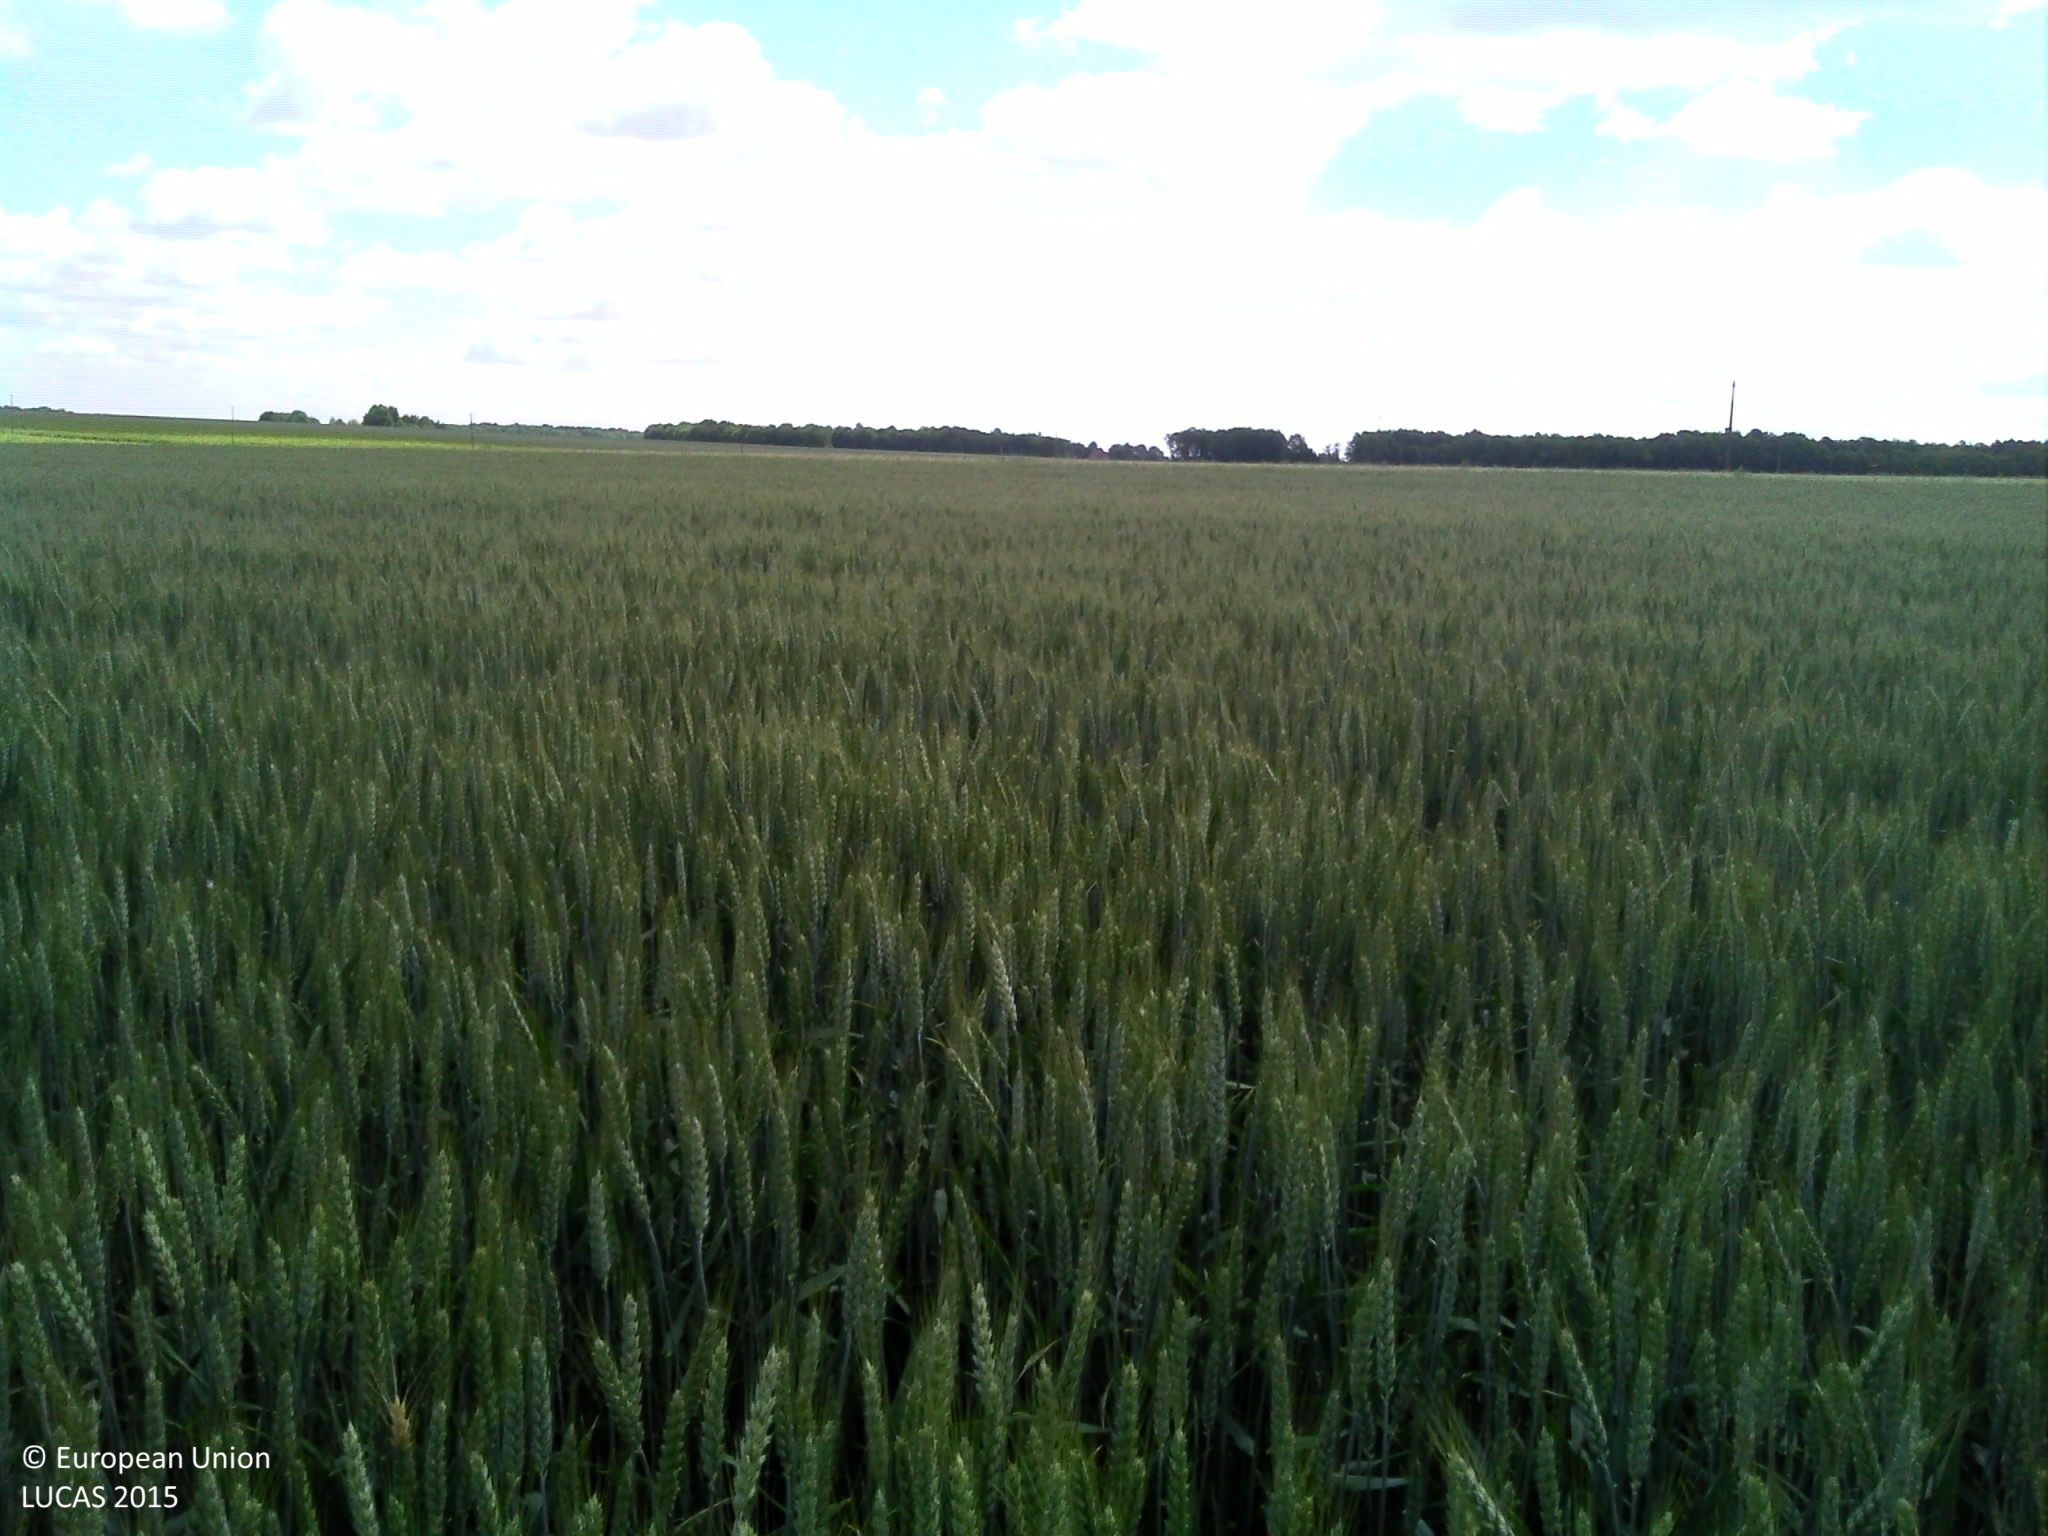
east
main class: Cropland
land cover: Durum wheat
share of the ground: > 75 %
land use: Agriculture (excluding fallow land and kitchen gardens)
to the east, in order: Durum wheat; Grass margins; Ditches and canals; Grass margins; Paved roads, cycling and walking lanes; Grass margins; Ditches and canals; Grass margins; Electric lines; Barley
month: May
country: FR
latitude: 47.2960
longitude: 1.0308
